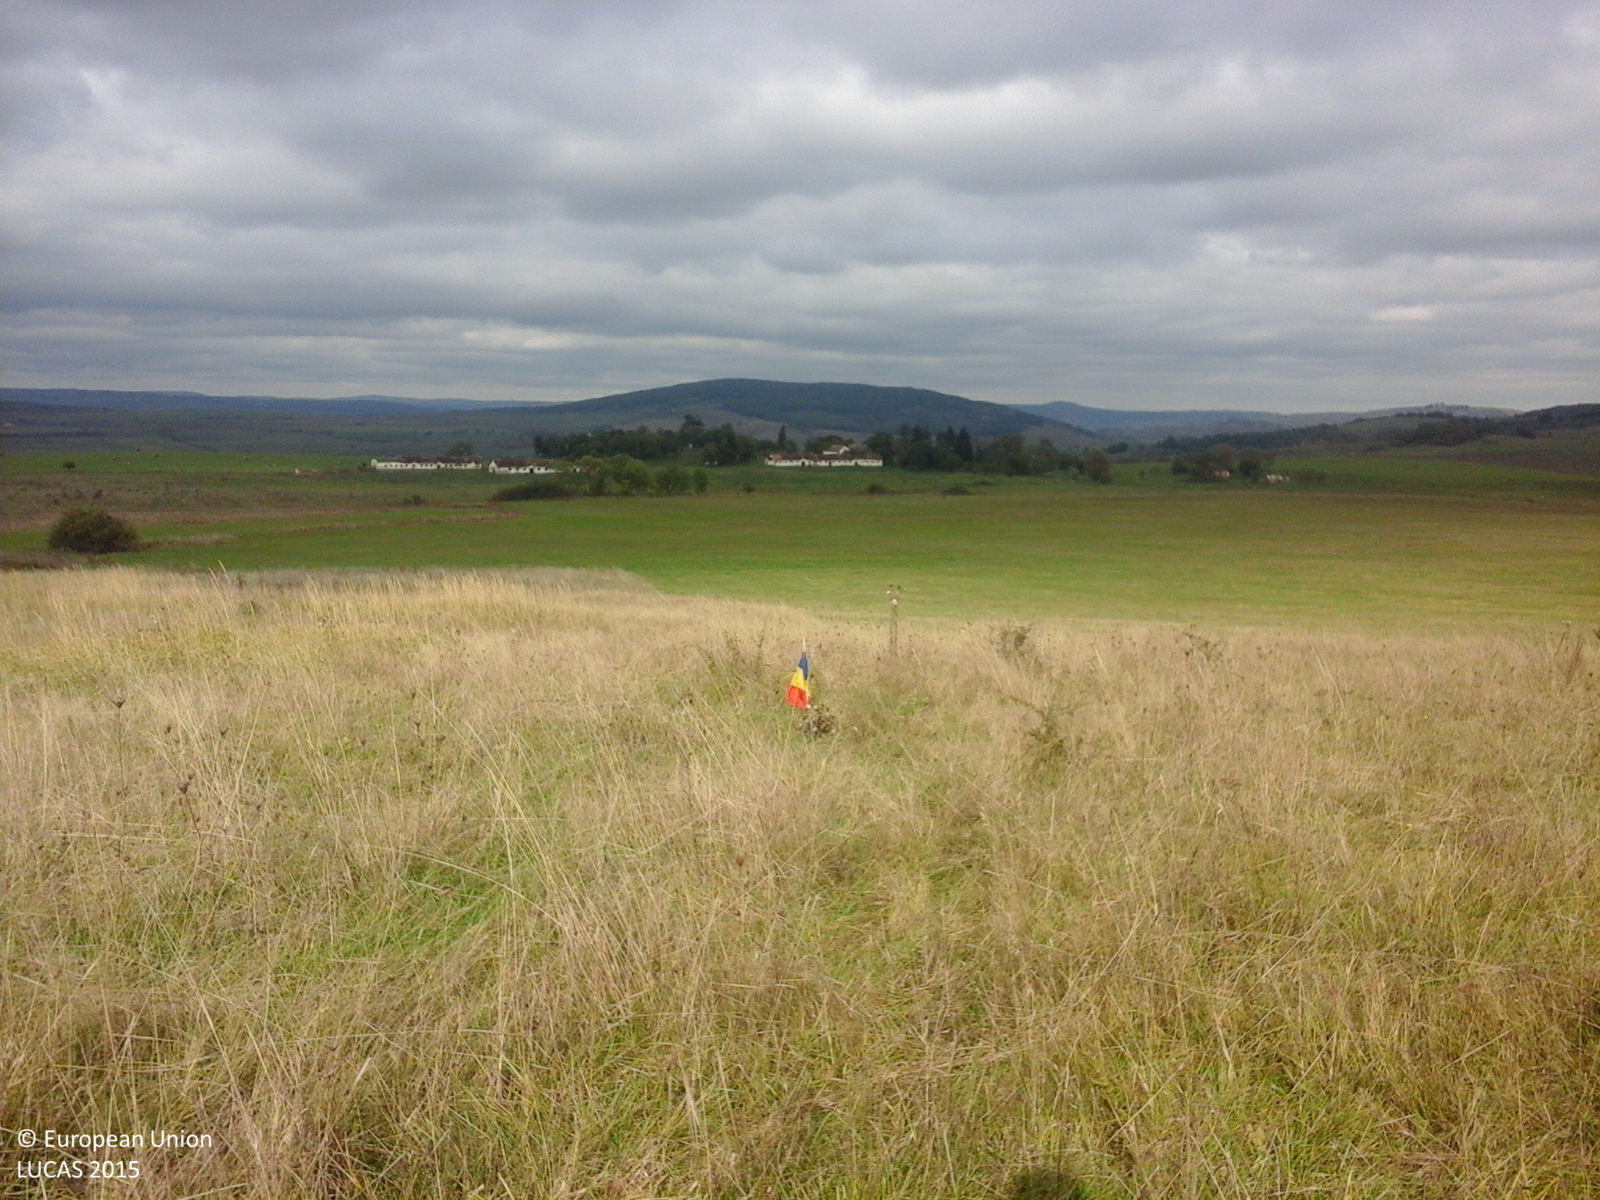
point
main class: Grassland
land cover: Grassland without tree/shrub cover
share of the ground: > 75 %
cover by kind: herbaceous plants 100 %
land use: Agriculture (excluding fallow land and kitchen gardens)
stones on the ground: < 10 %
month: October
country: RO
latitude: 45.9397
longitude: 24.6481
